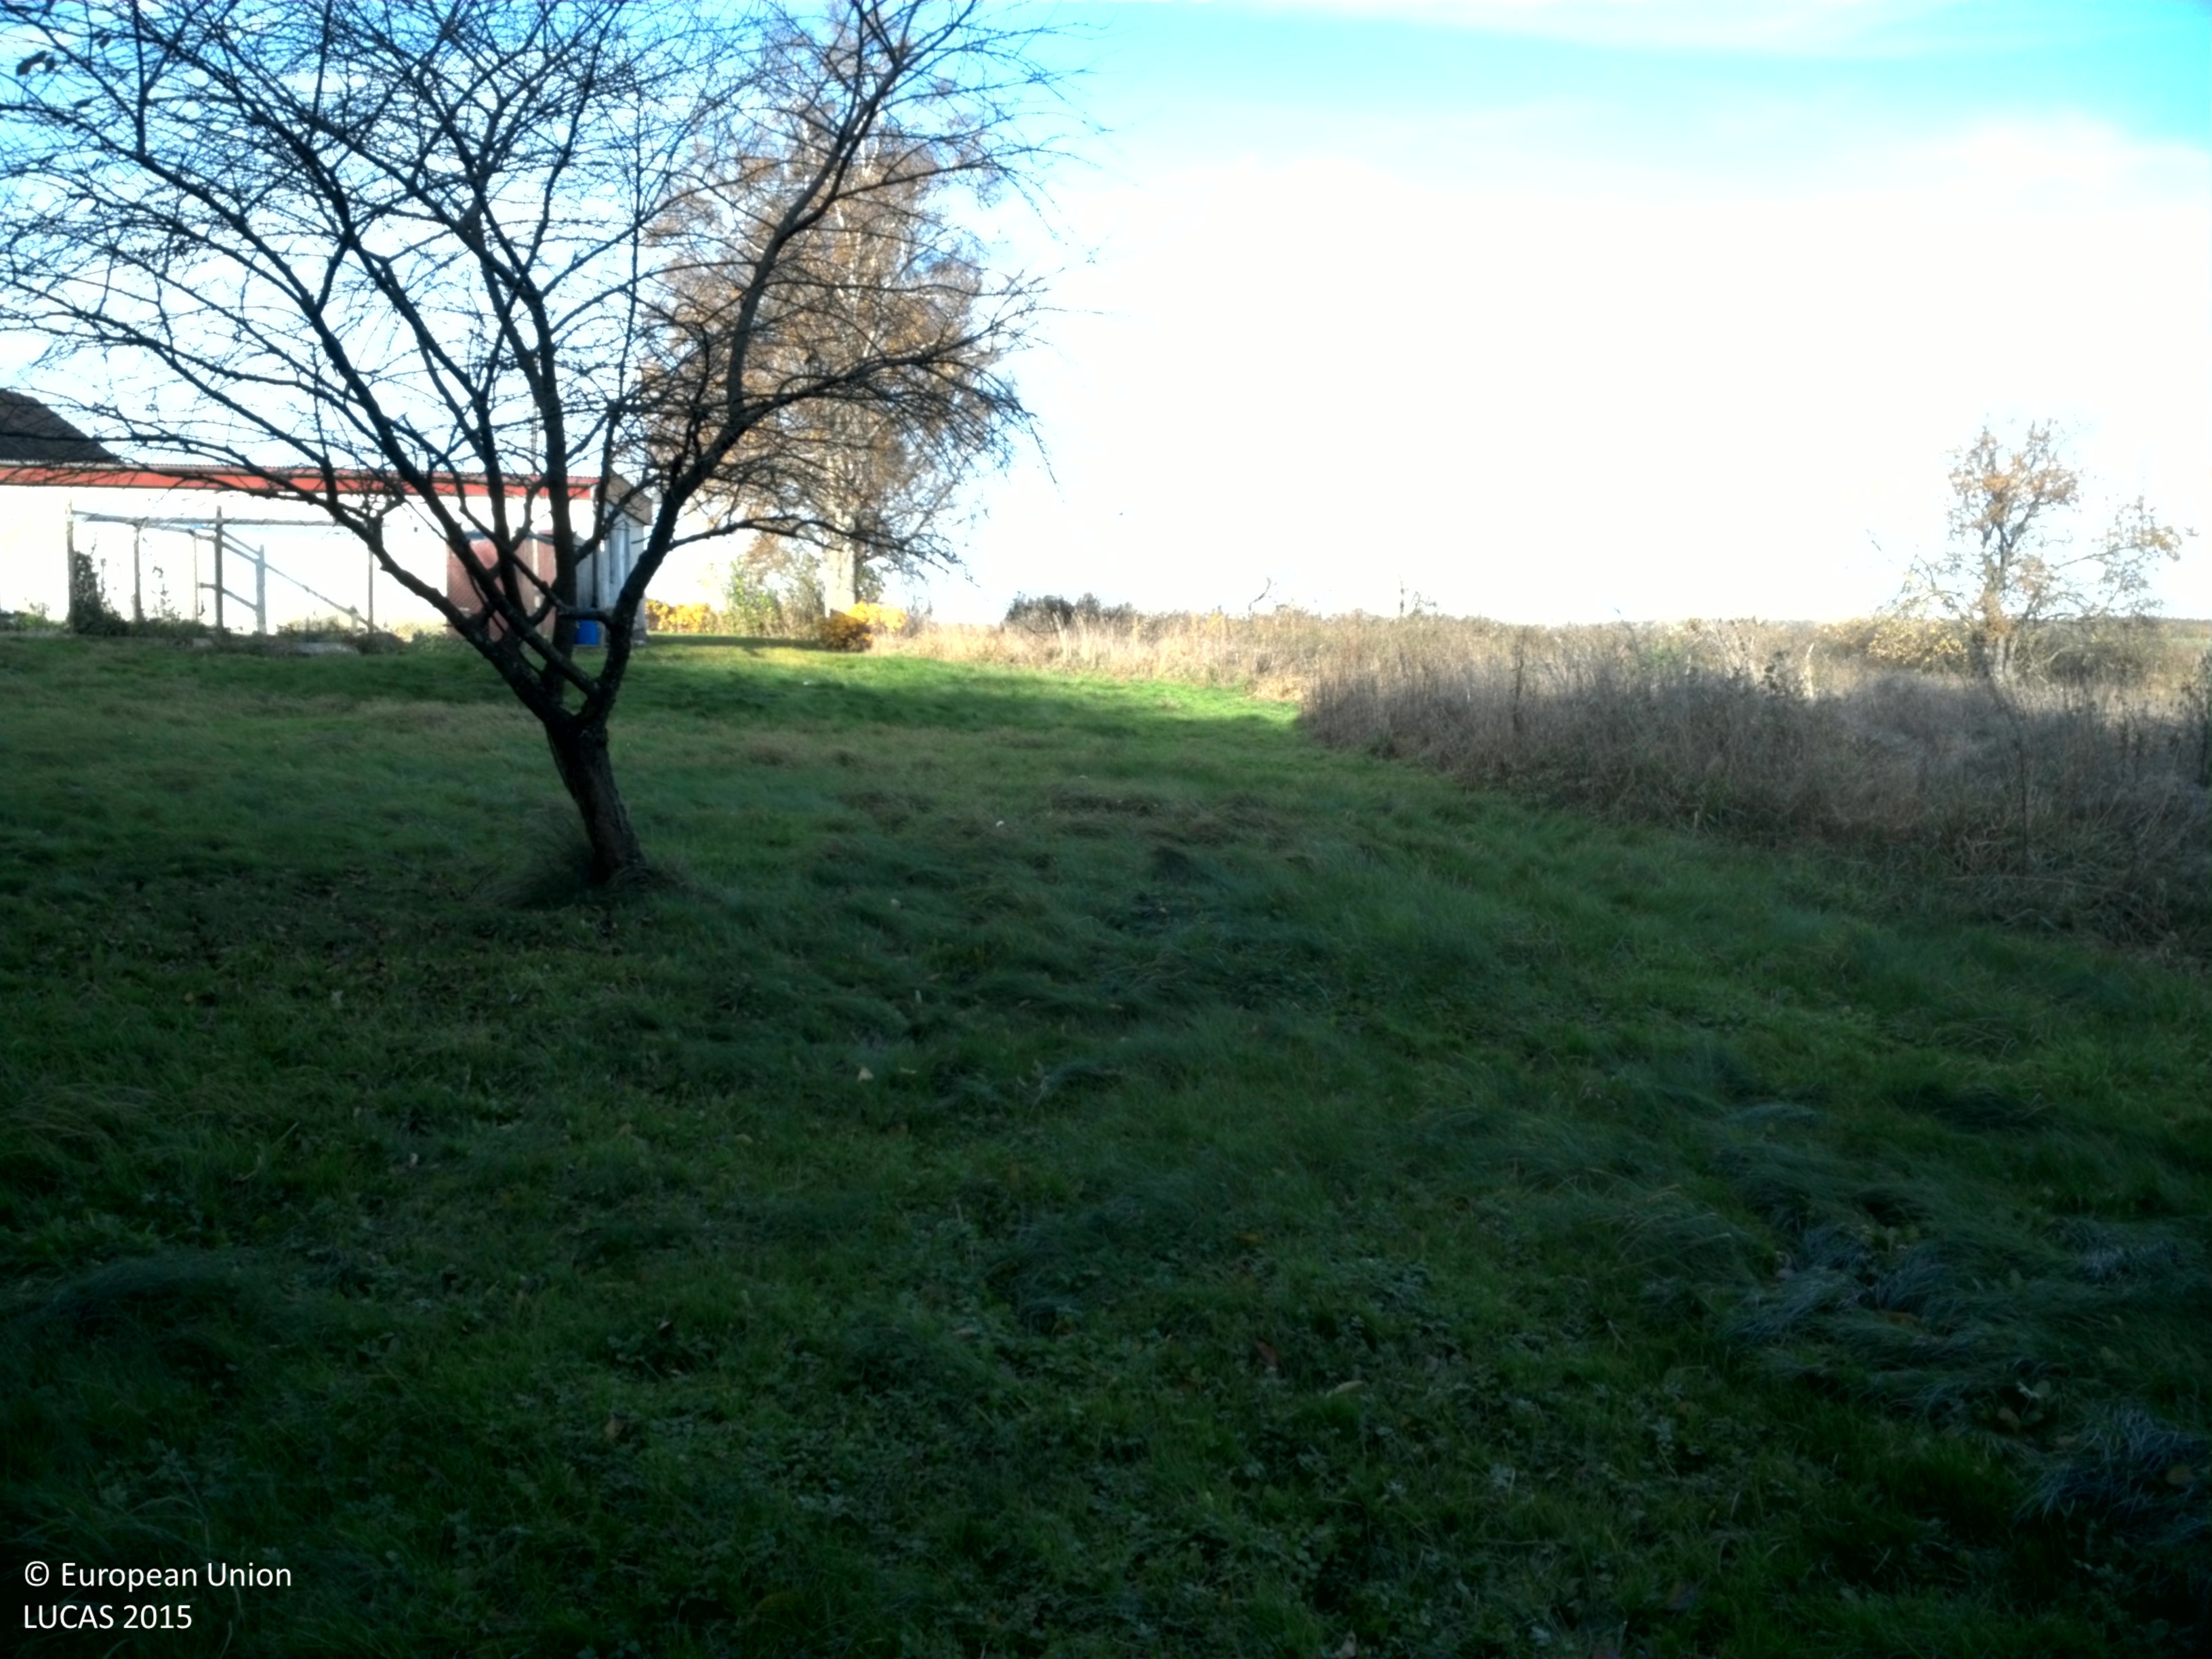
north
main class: Grassland
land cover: Grassland with sparse tree/shrub cover
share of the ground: > 75 %
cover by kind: herbaceous plants 95 %, broadleaved forest trees 5 %
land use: Residential
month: October
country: SE
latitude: 55.9348
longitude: 13.0872
